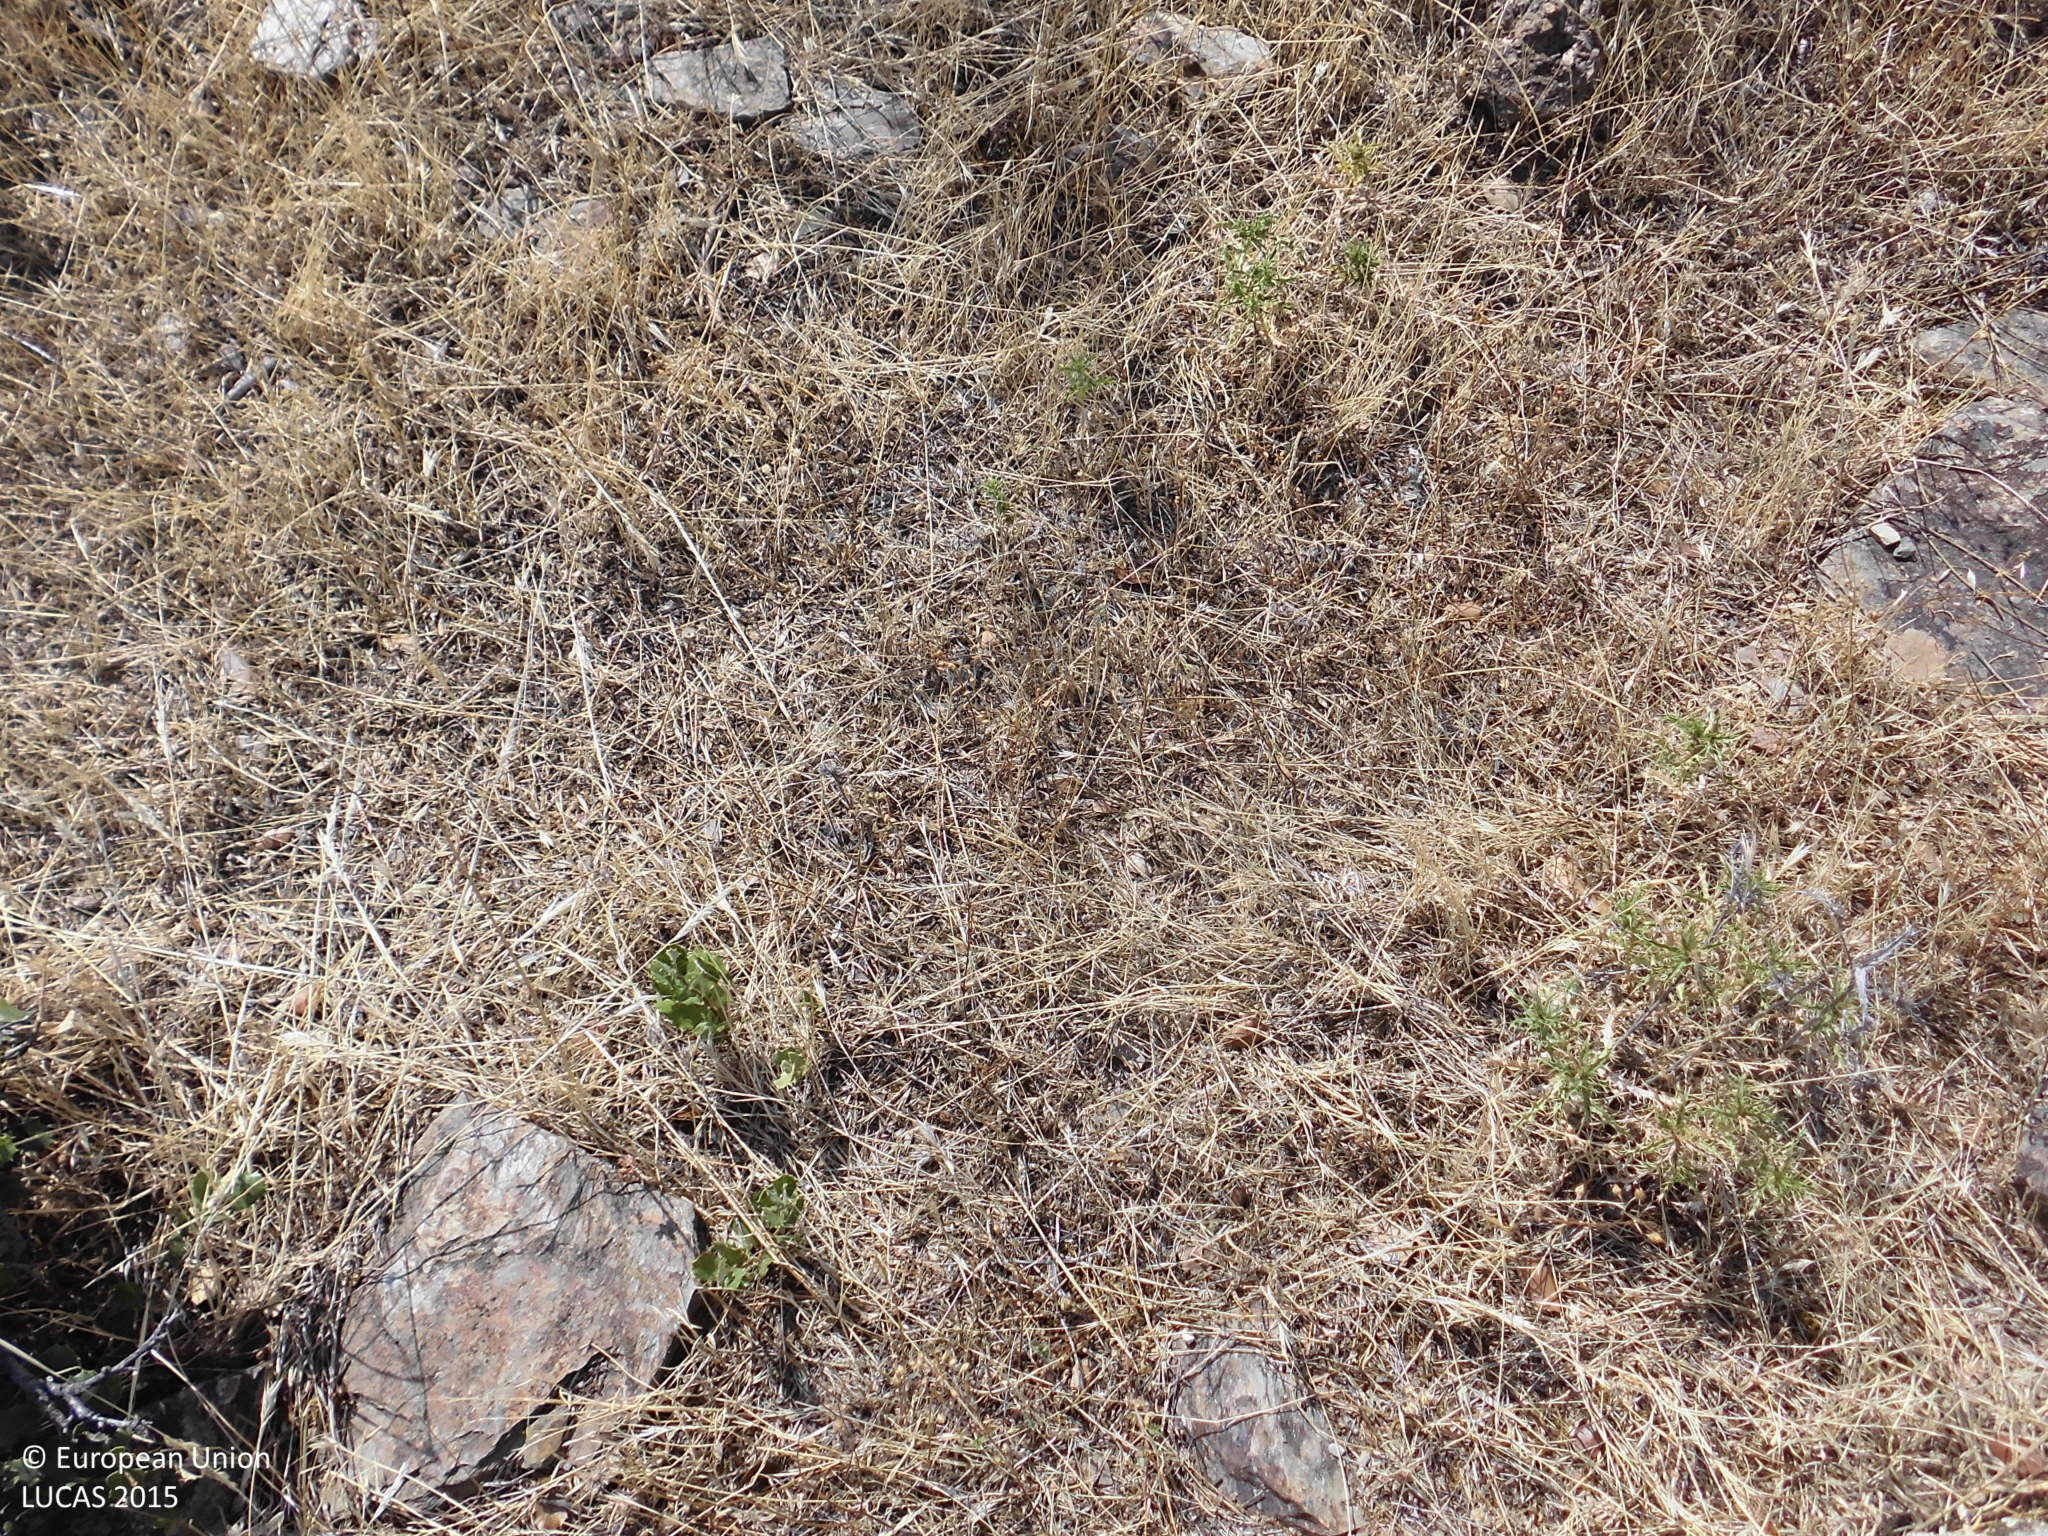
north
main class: Woodland
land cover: Broadleaved woodland
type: broadleaved evergreen forest
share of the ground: 10 - 25 %
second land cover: Grassland without tree/shrub cover
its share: 50 - 75 %
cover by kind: herbaceous plants 75 %, broadleaved forest trees 25 %
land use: Forestry
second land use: Agriculture (excluding fallow land and kitchen gardens)
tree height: > 5 m
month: June
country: ES
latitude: 39.4825
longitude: -5.5263
